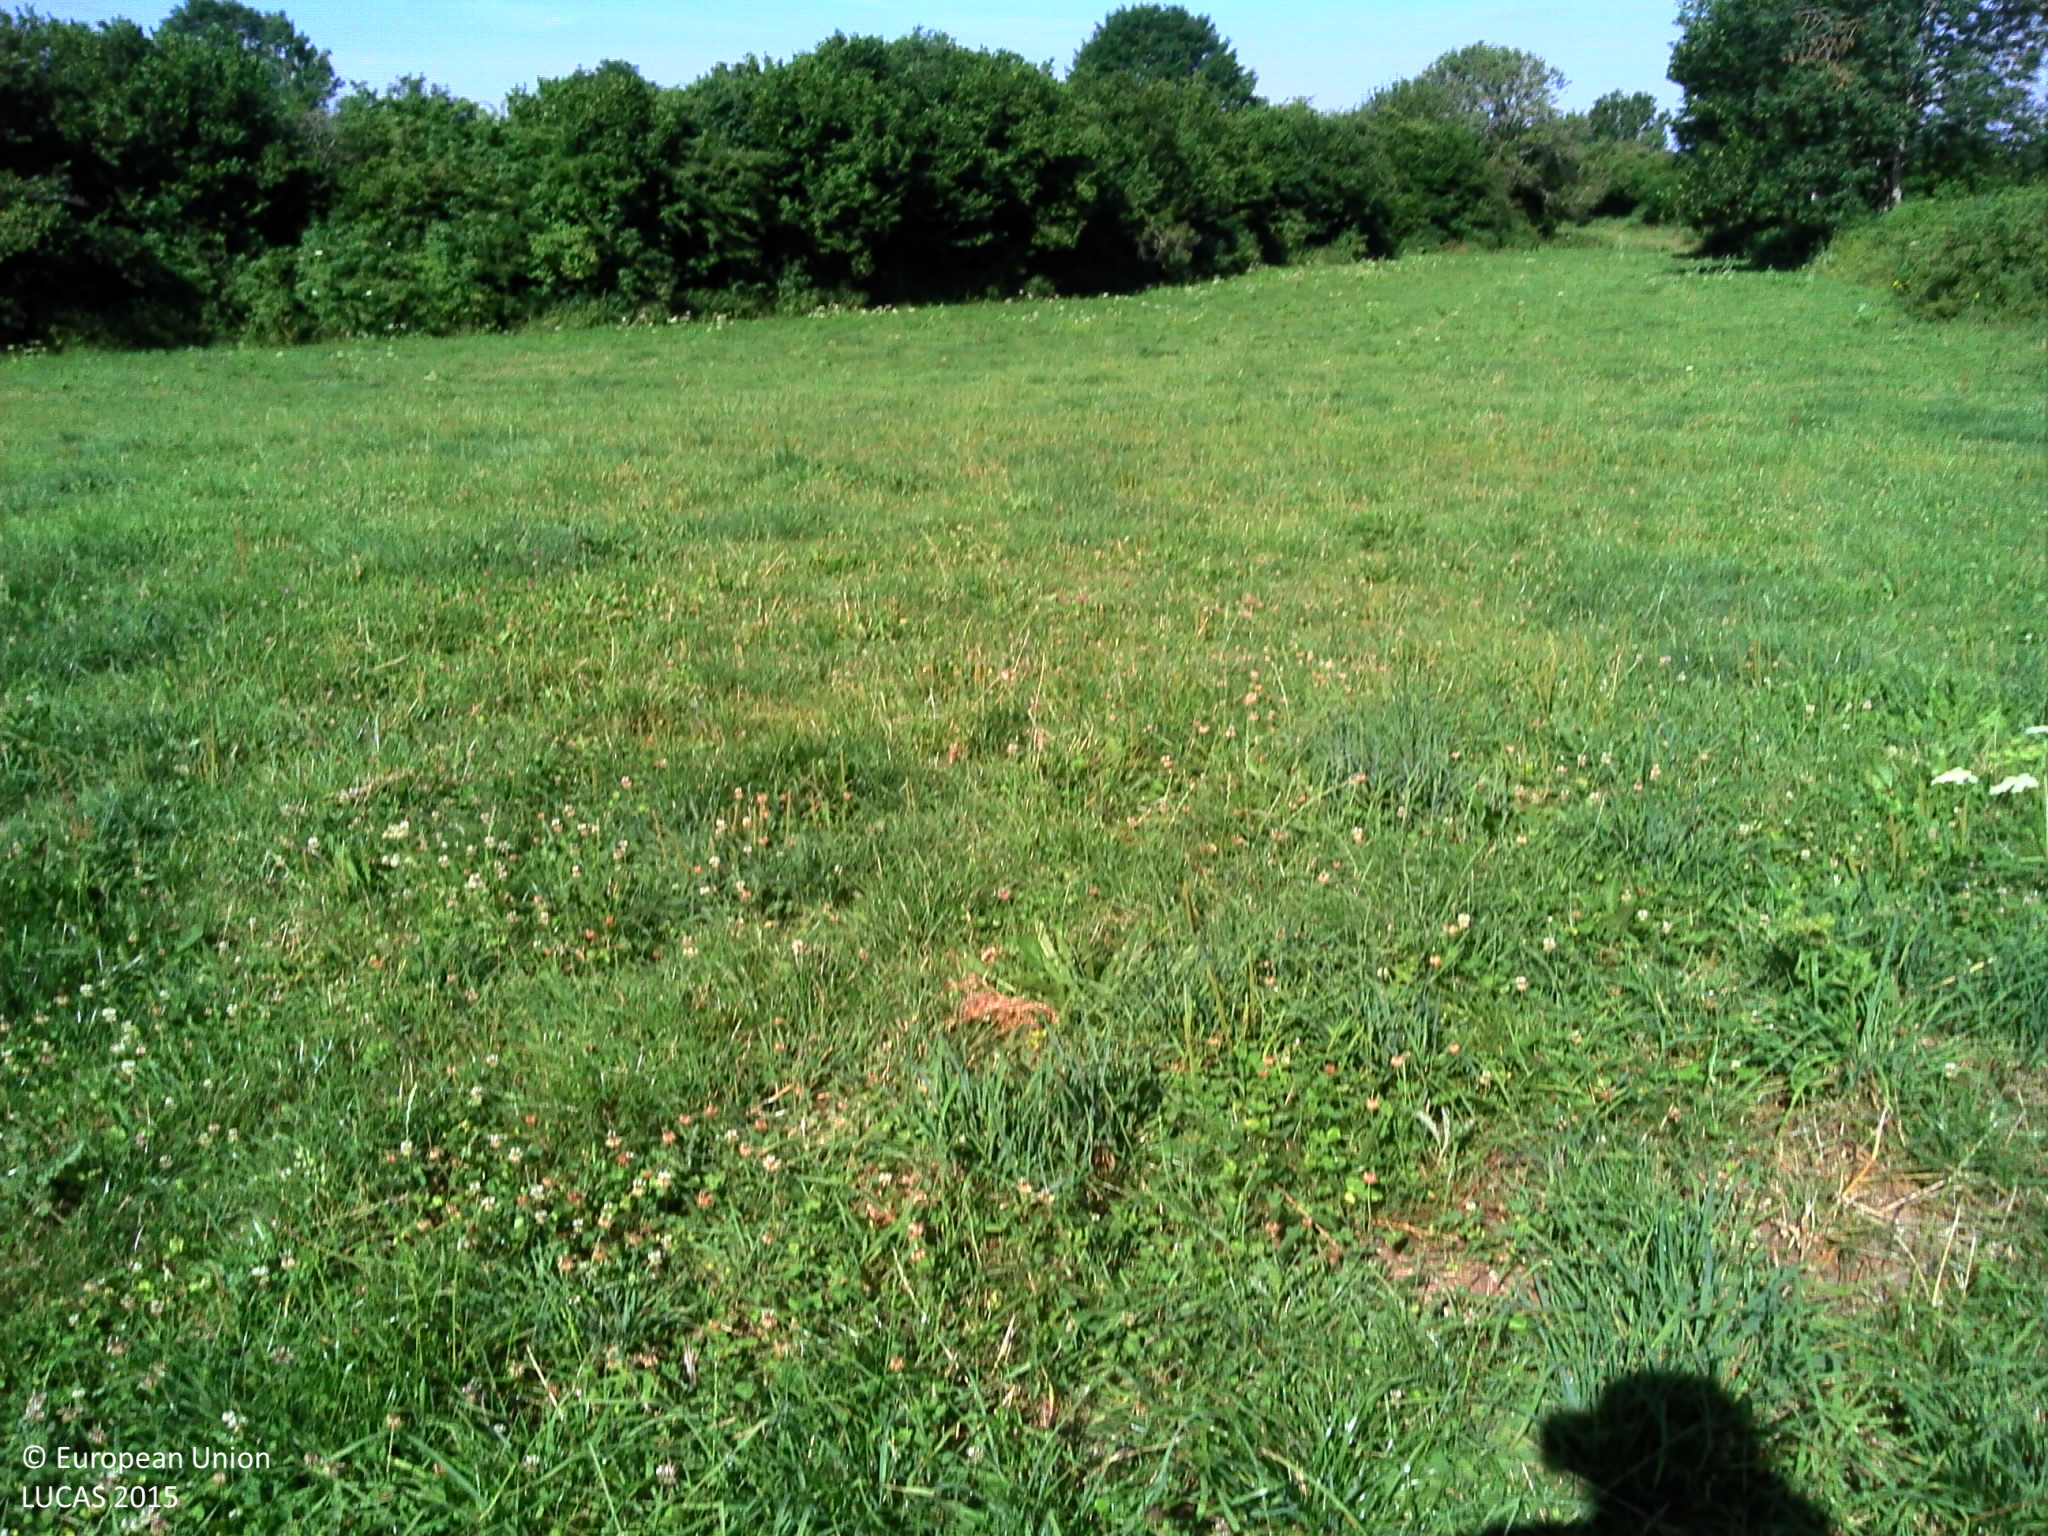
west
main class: Shrubland
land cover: Shrubland without tree cover
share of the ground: > 75 %
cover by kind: shrubs 100 %
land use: Agriculture (excluding fallow land and kitchen gardens)
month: July
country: FR
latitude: 46.7863
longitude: 6.1383
